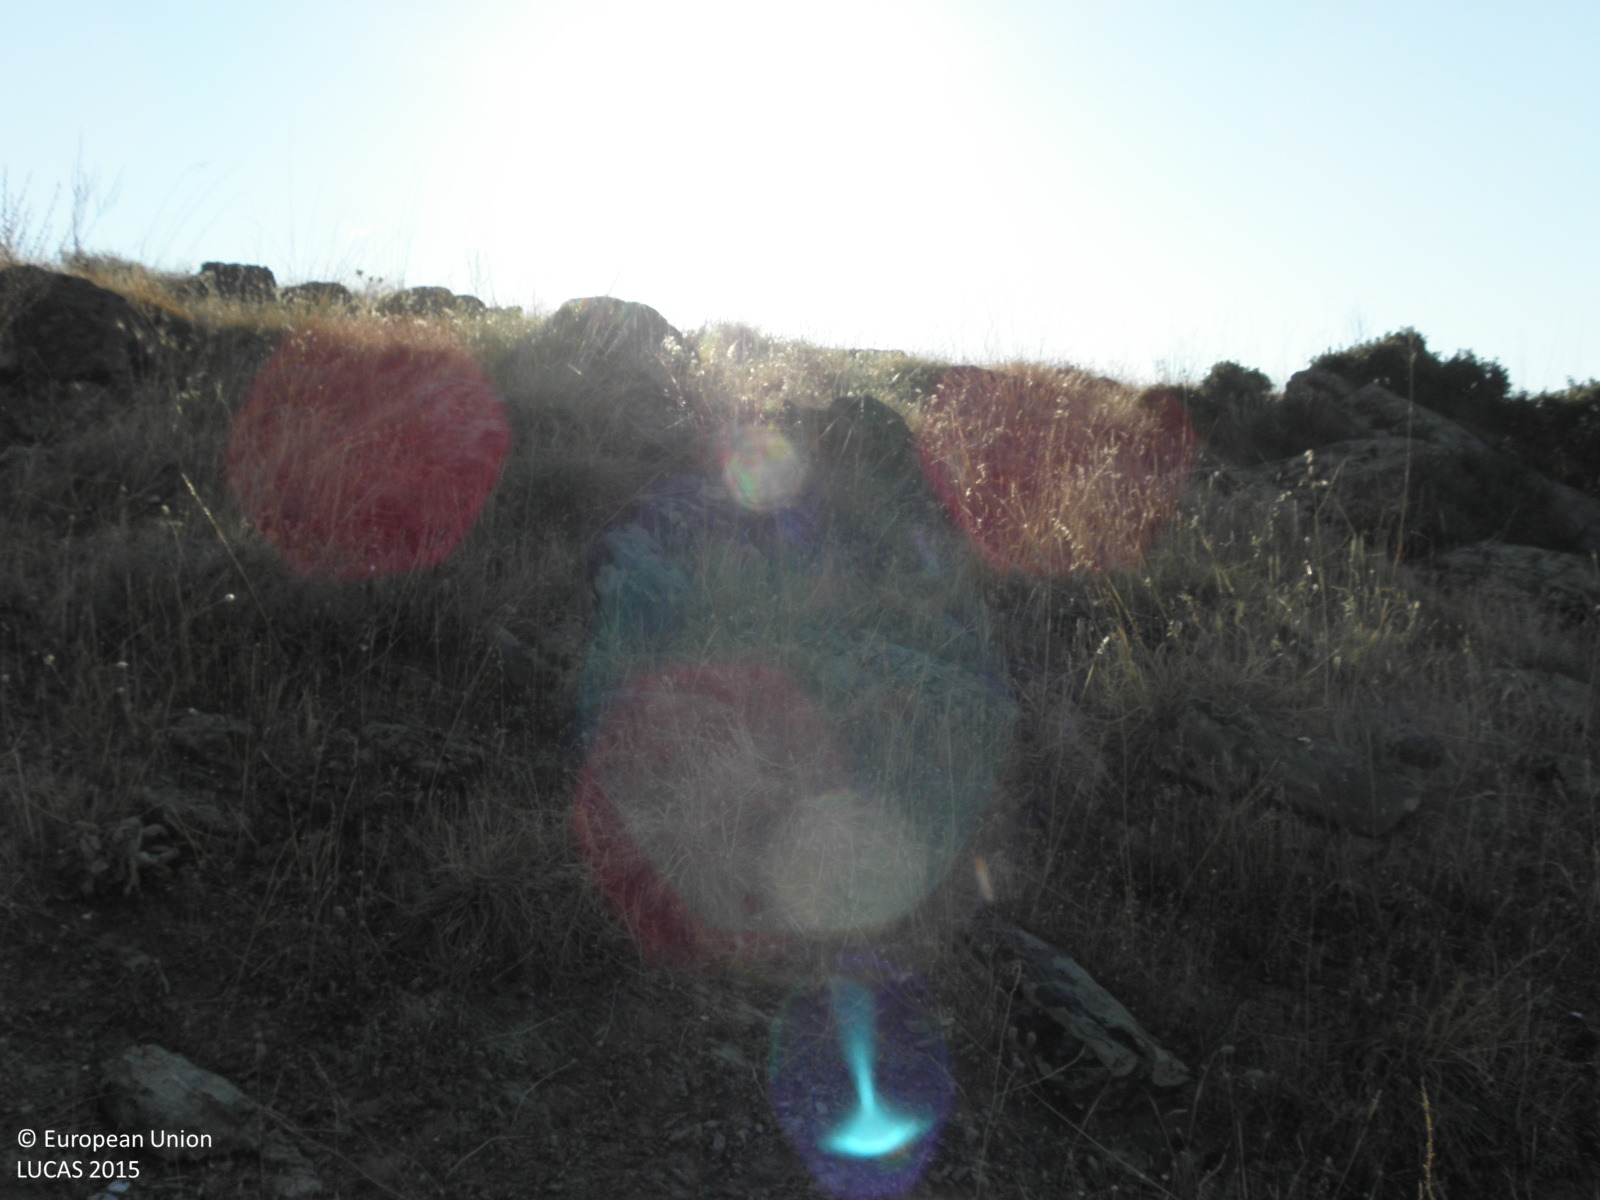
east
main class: Shrubland
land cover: Shrubland without tree cover
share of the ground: 25 - 50 %
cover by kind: shrubs 40 %, herbaceous plants 30 %, consolidated bare surface 30 %
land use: Semi-natural and natural areas not in use
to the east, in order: Shrubland without tree cover; Rock outcrops; Shrubland without tree cover; Rock outcrops; Shrubland without tree cover
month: September
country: GR
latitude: 39.7194
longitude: 22.5089
